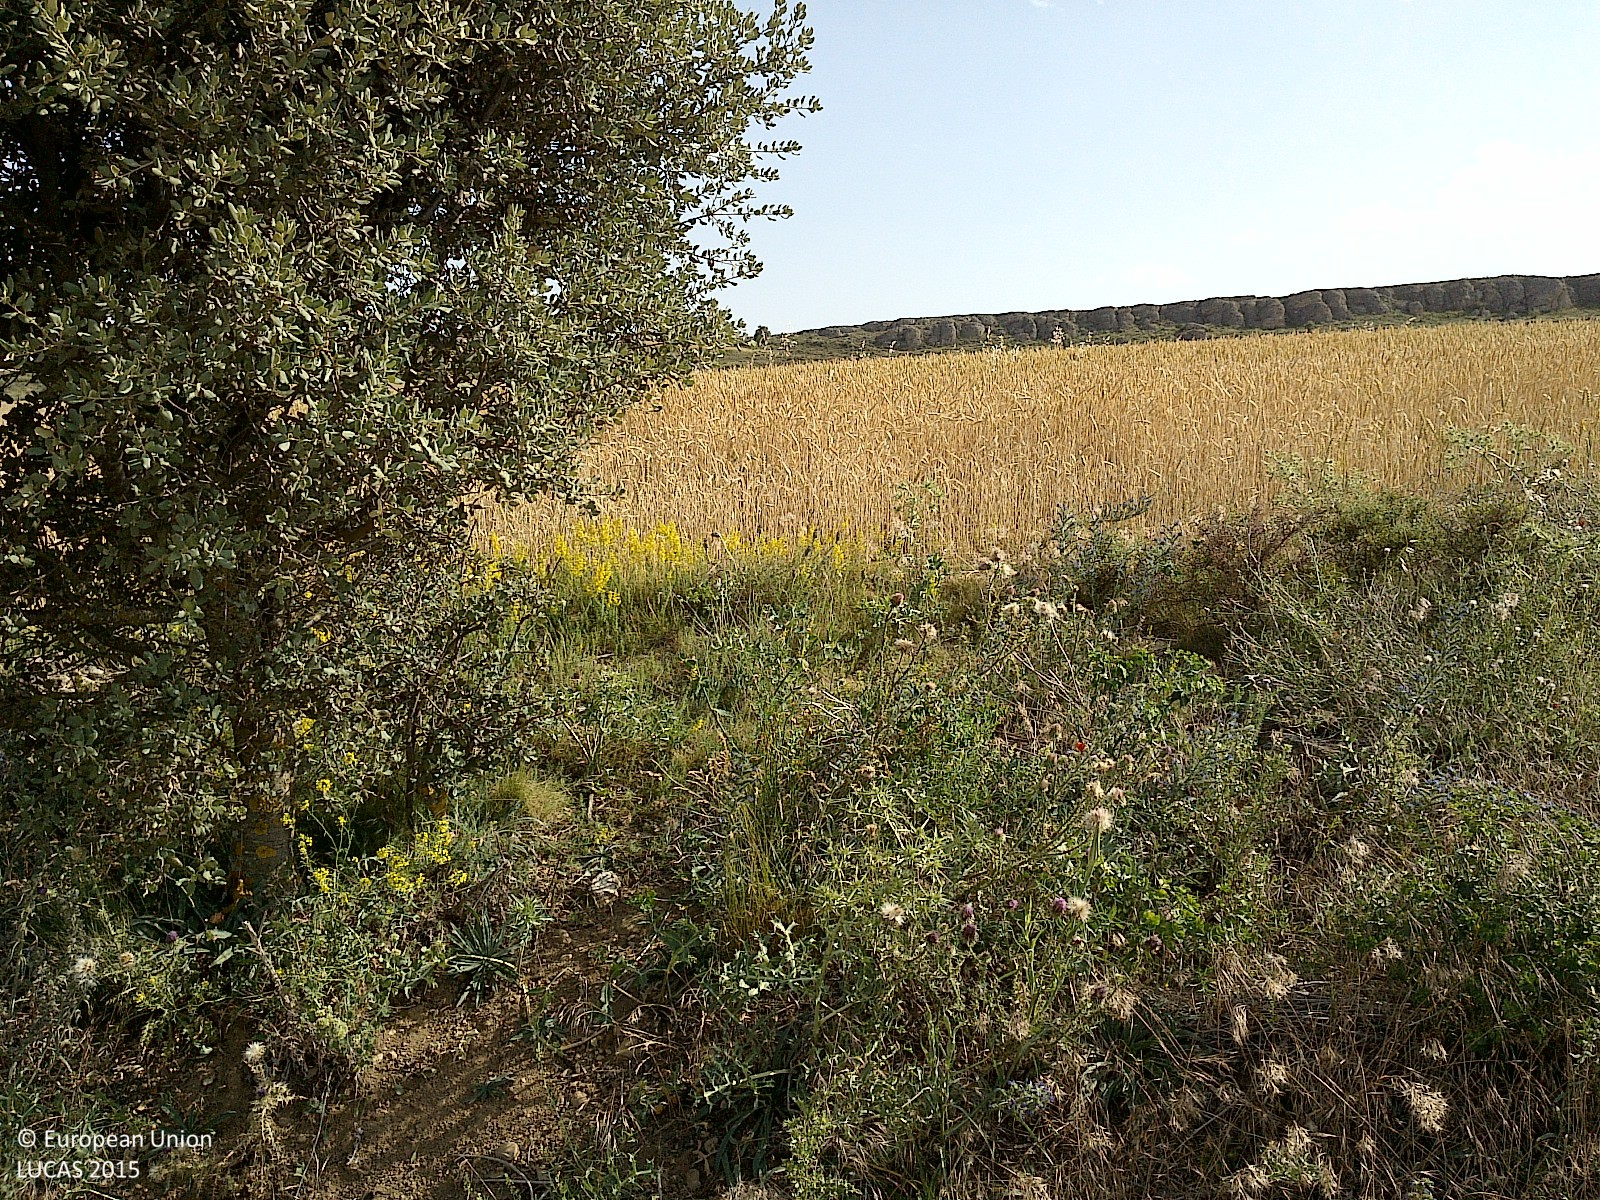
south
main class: Cropland
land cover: Common wheat
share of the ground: > 75 %
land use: Agriculture (excluding fallow land and kitchen gardens)
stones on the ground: < 10 %
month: June
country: ES
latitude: 41.5634
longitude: -2.2282
